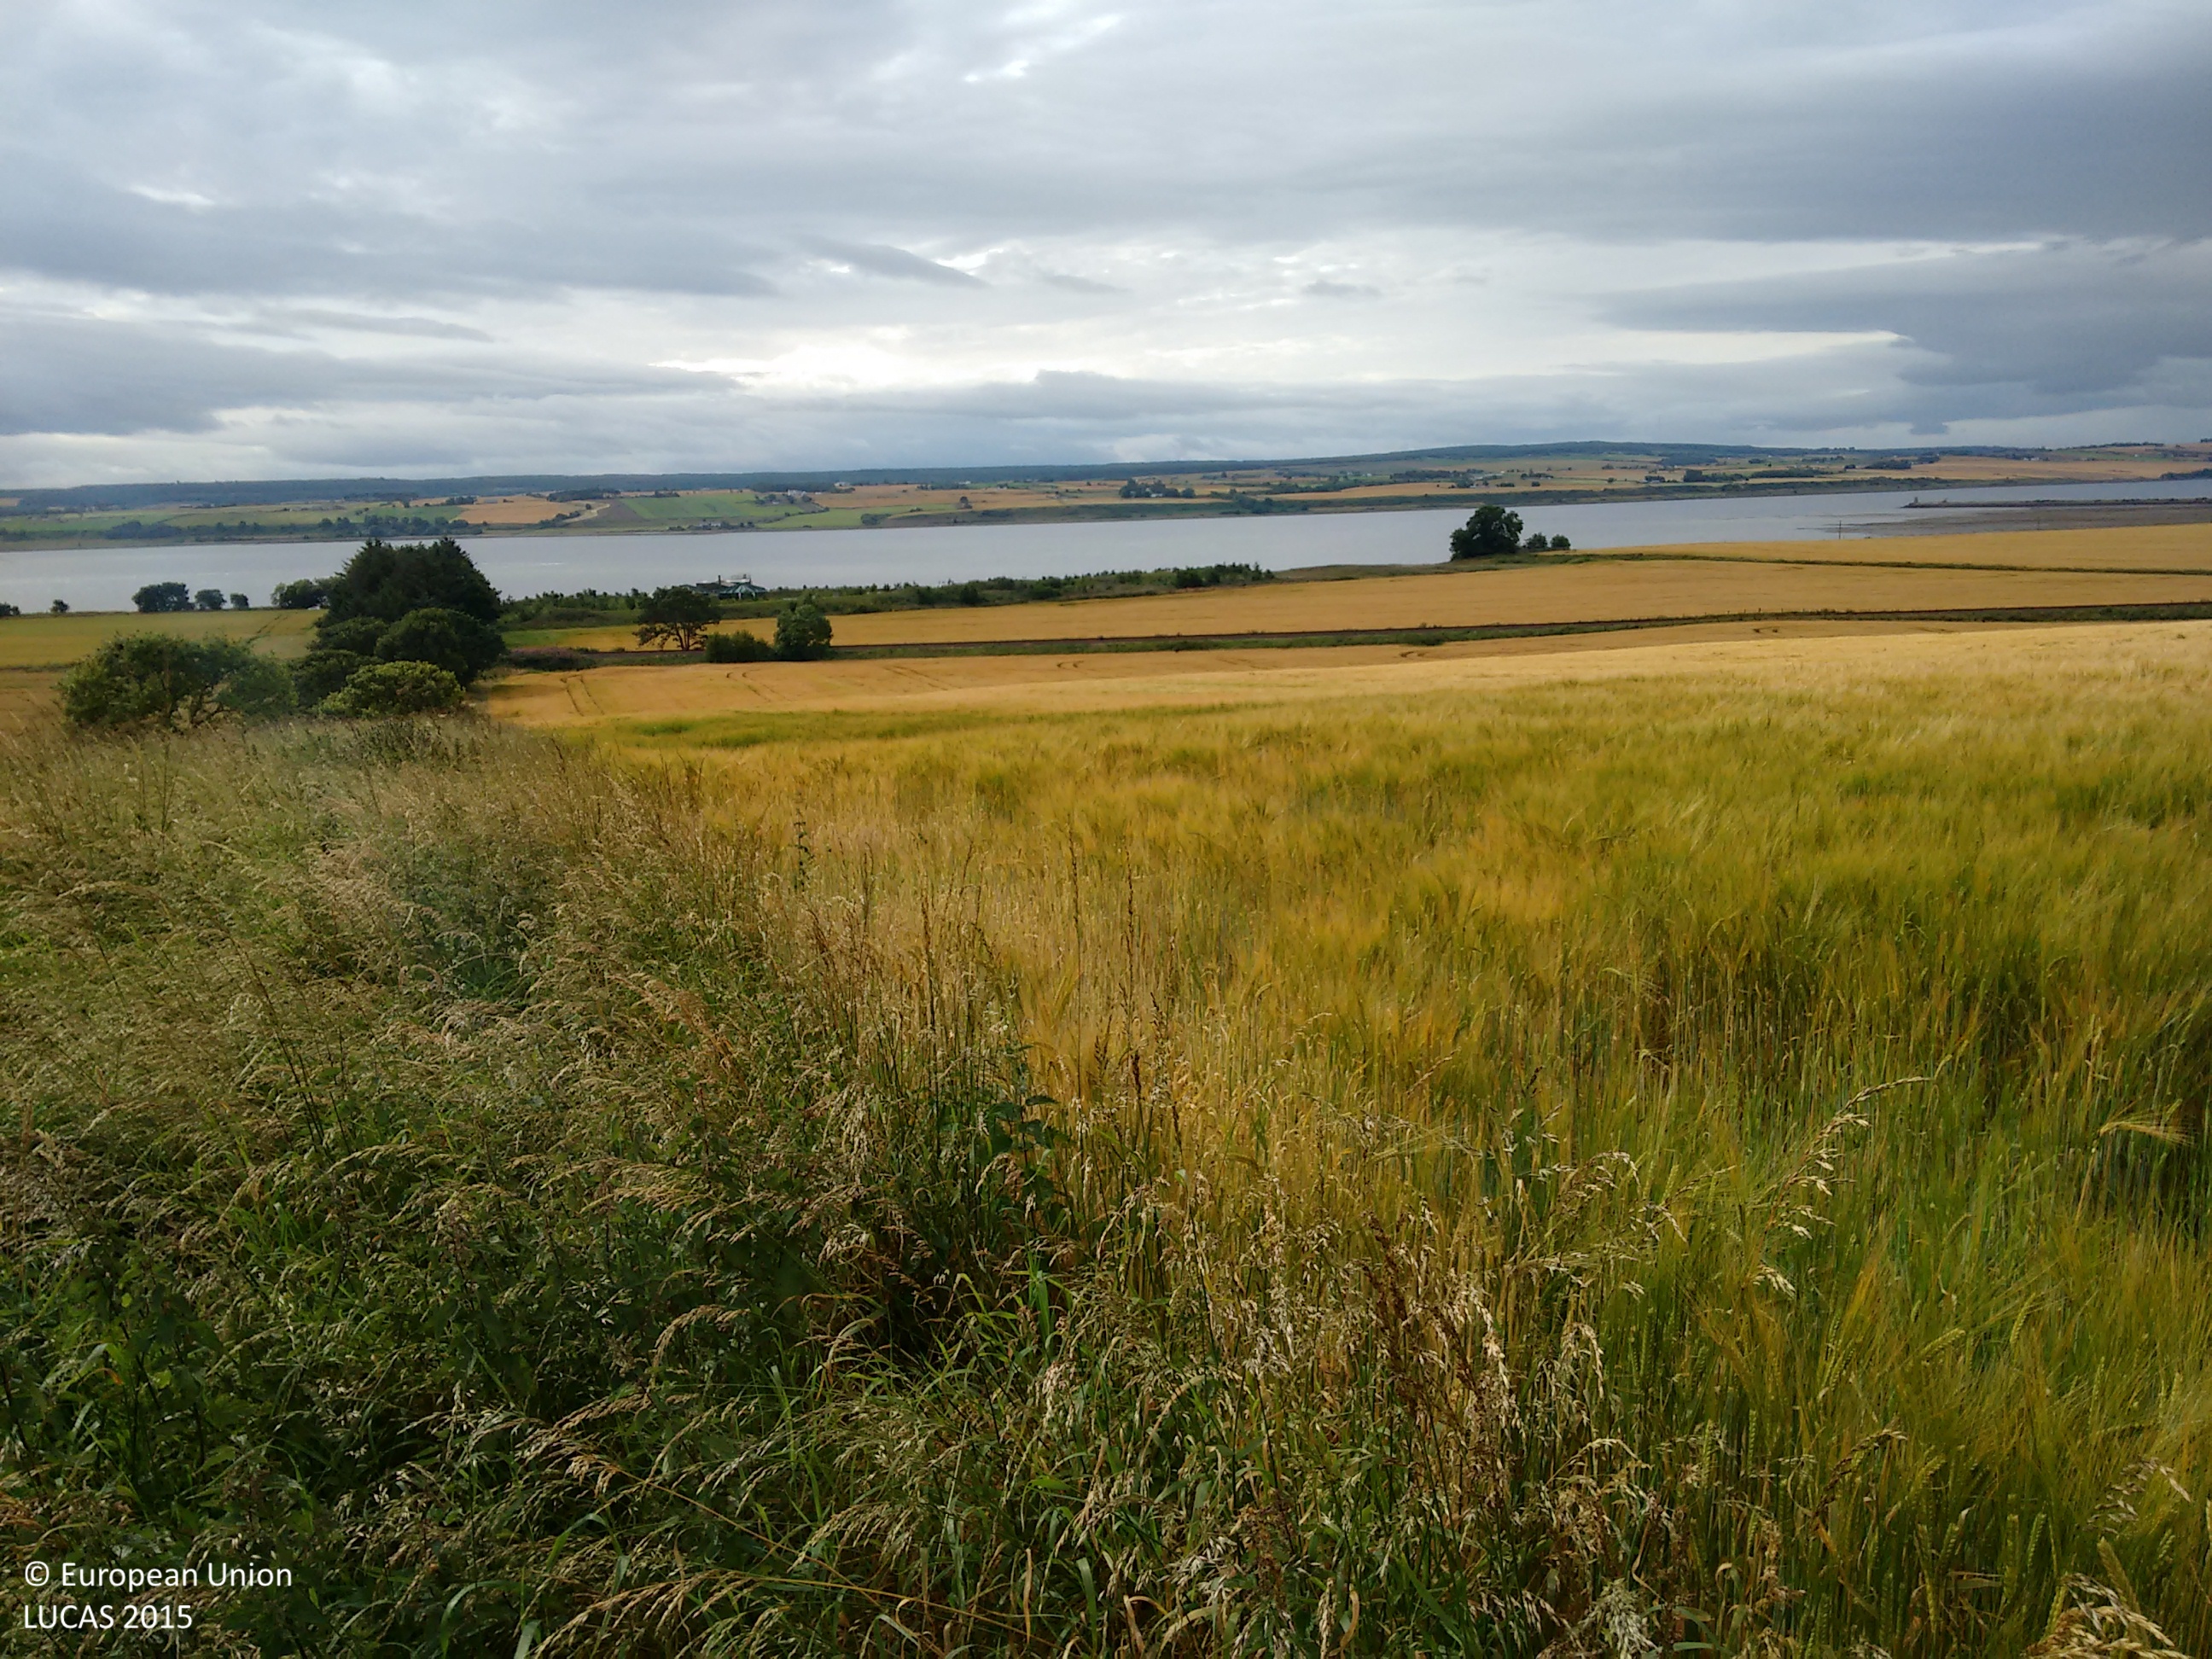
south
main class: Cropland
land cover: Barley
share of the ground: > 75 %
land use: Agriculture (excluding fallow land and kitchen gardens)
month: August
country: GB
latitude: 57.6952
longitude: -4.2269
